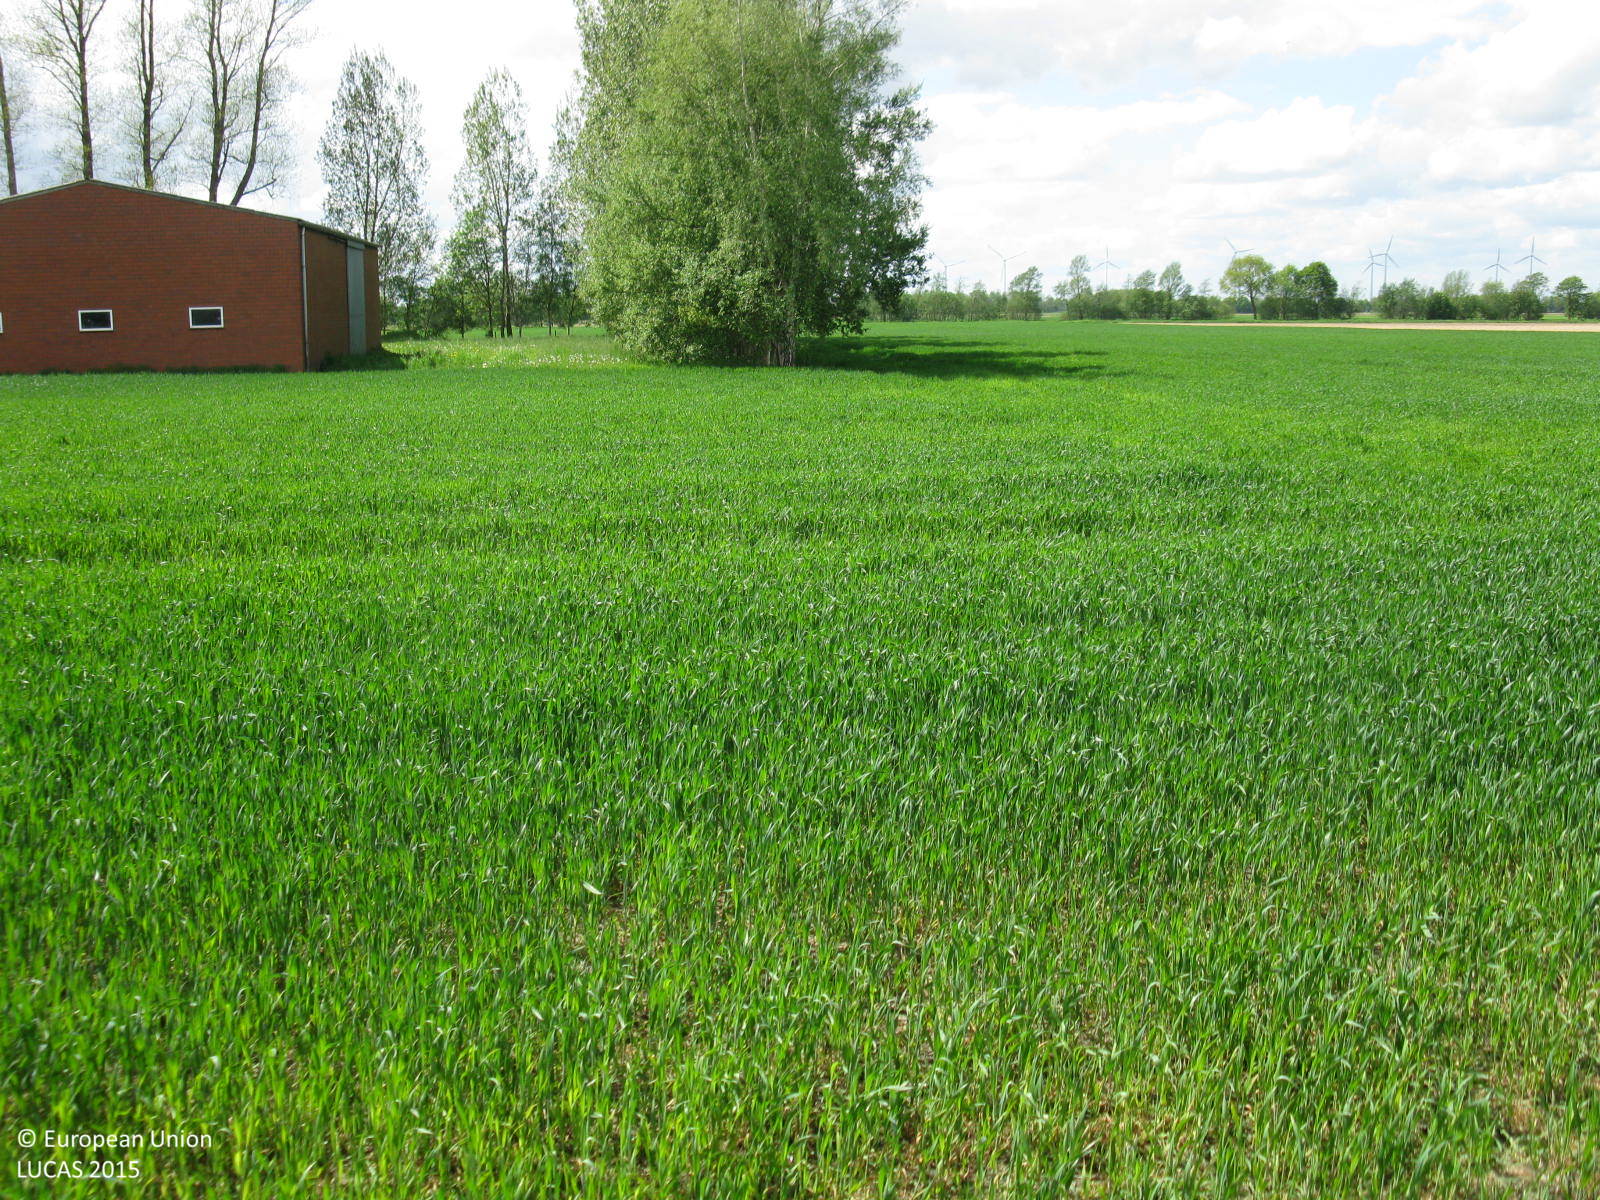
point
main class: Cropland
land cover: Common wheat
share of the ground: > 75 %
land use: Agriculture (excluding fallow land and kitchen gardens)
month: May
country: DE
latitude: 53.0123
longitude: 7.3027
